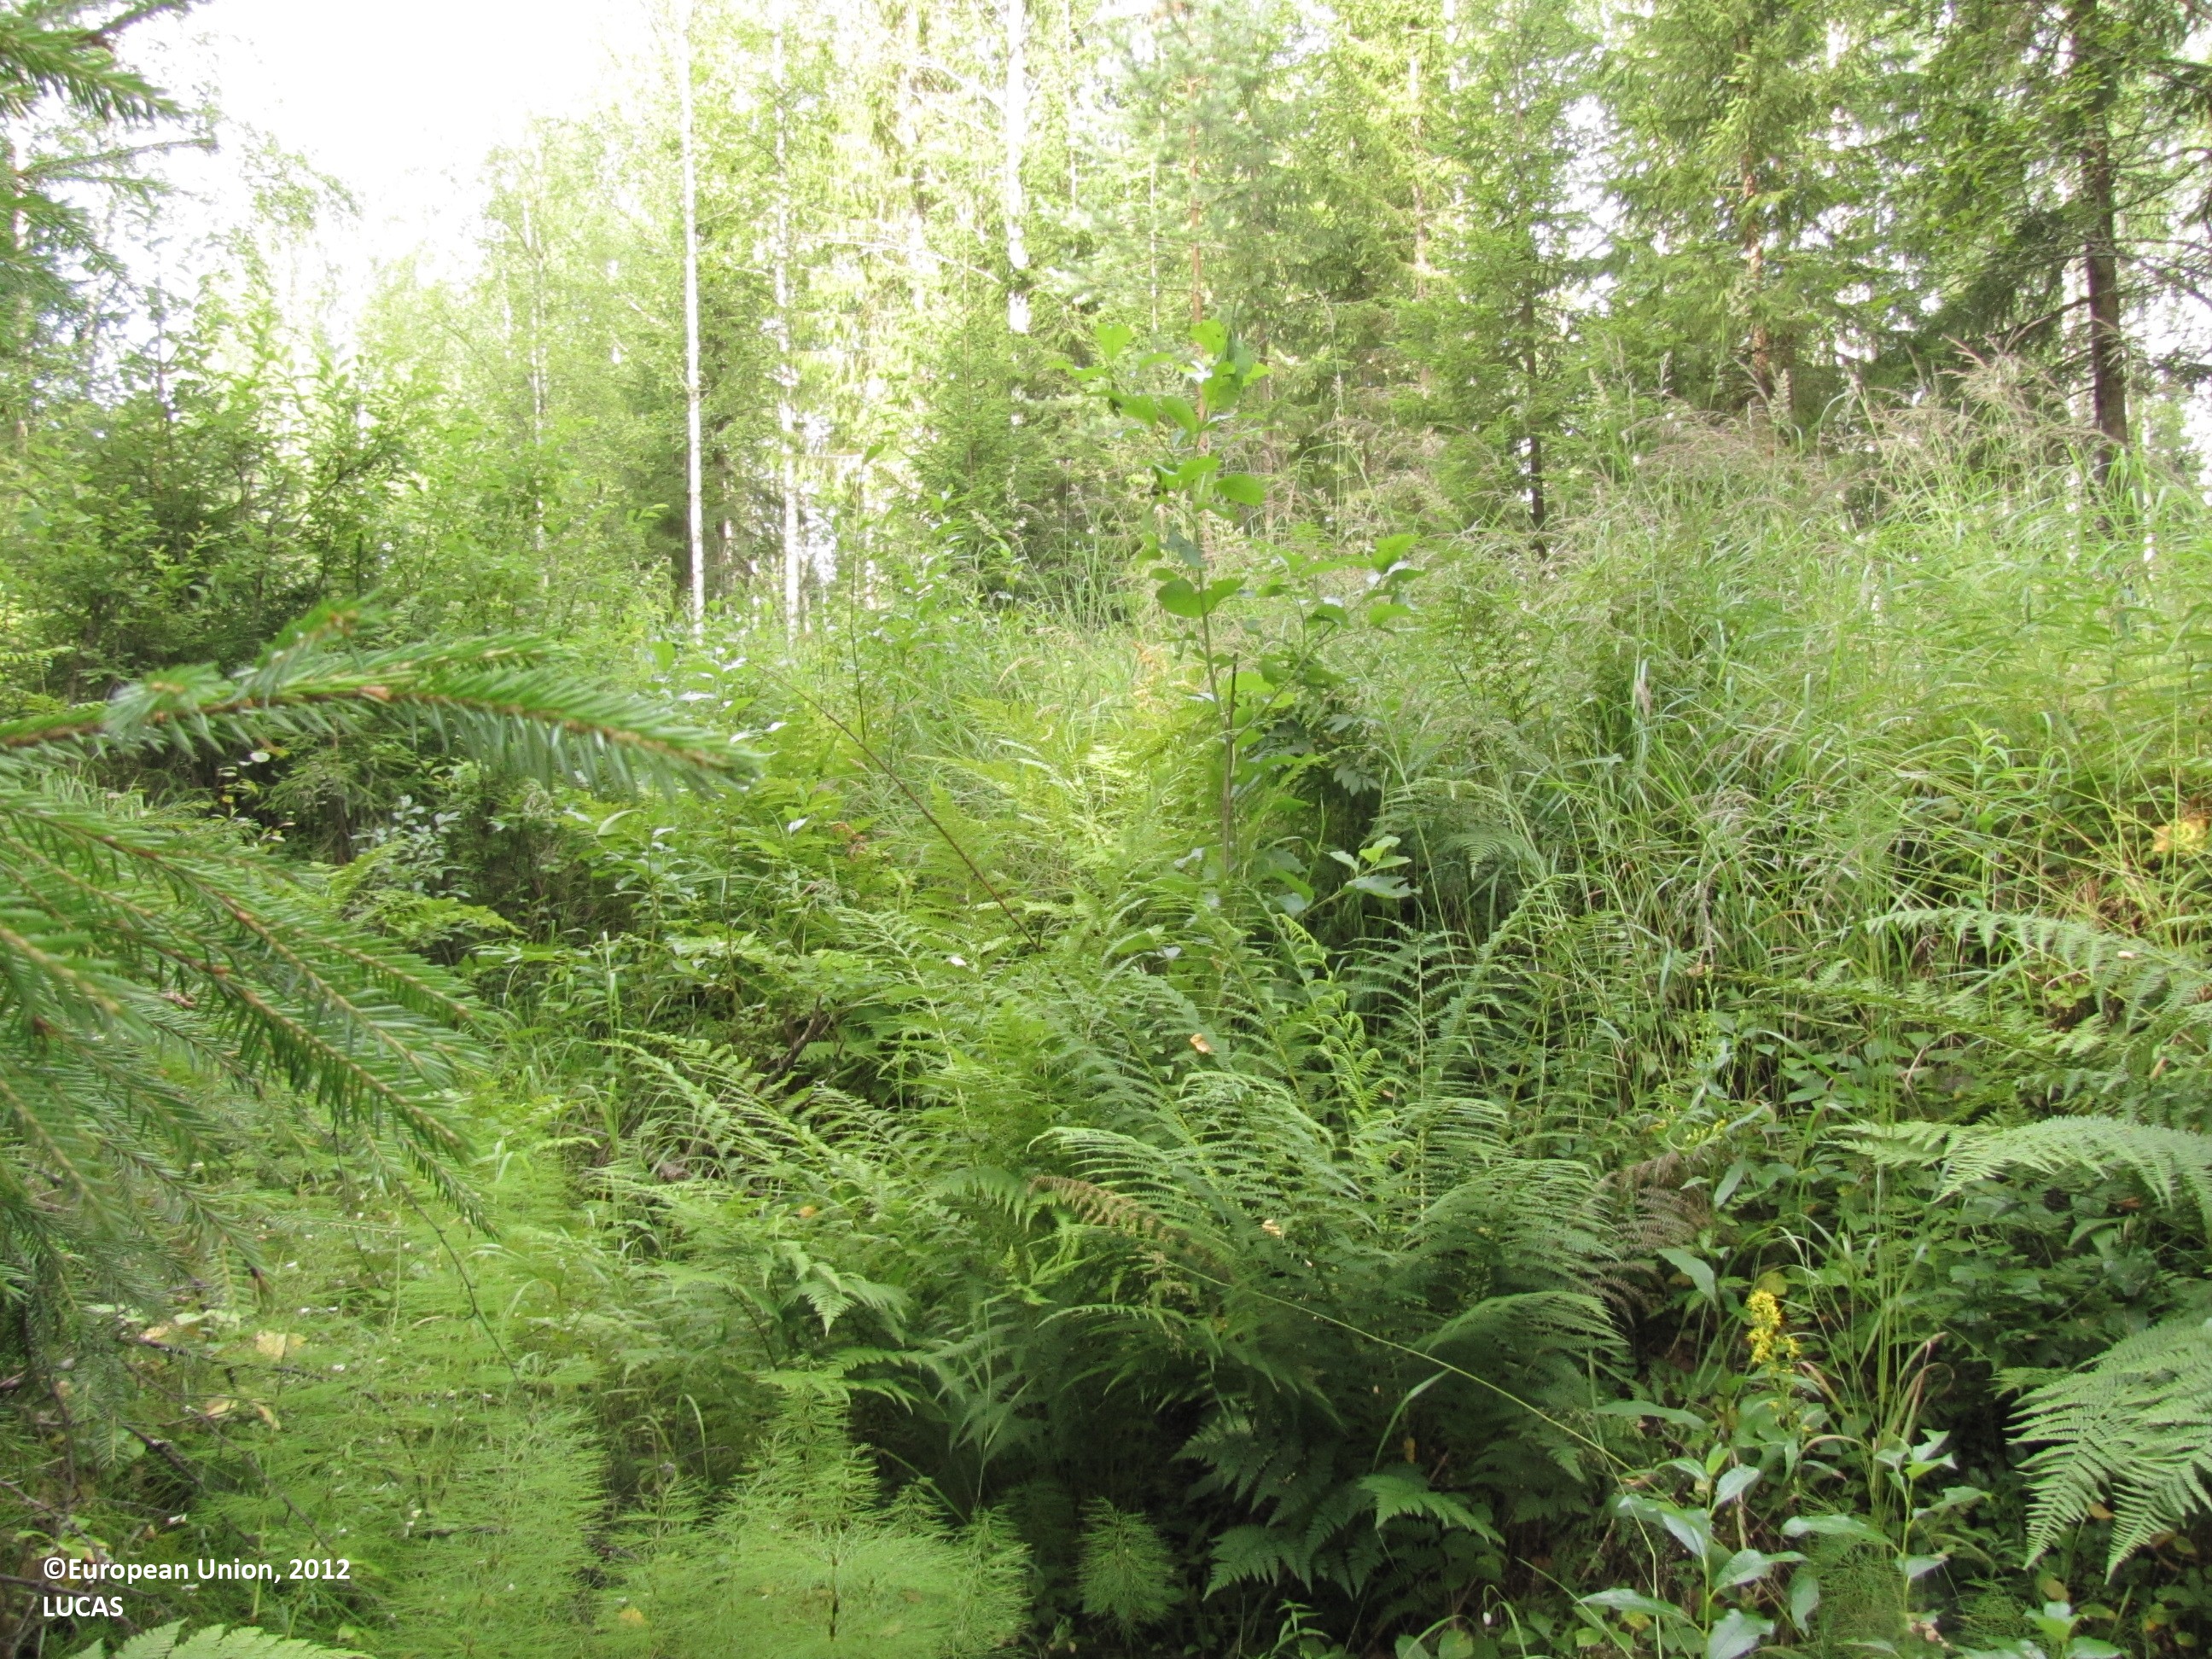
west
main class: Woodland
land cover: Other mixed woodland
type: boreal forest
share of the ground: 50 - 75 %
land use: Forestry
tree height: > 5 m
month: August
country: FI
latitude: 61.8956
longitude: 23.8401
